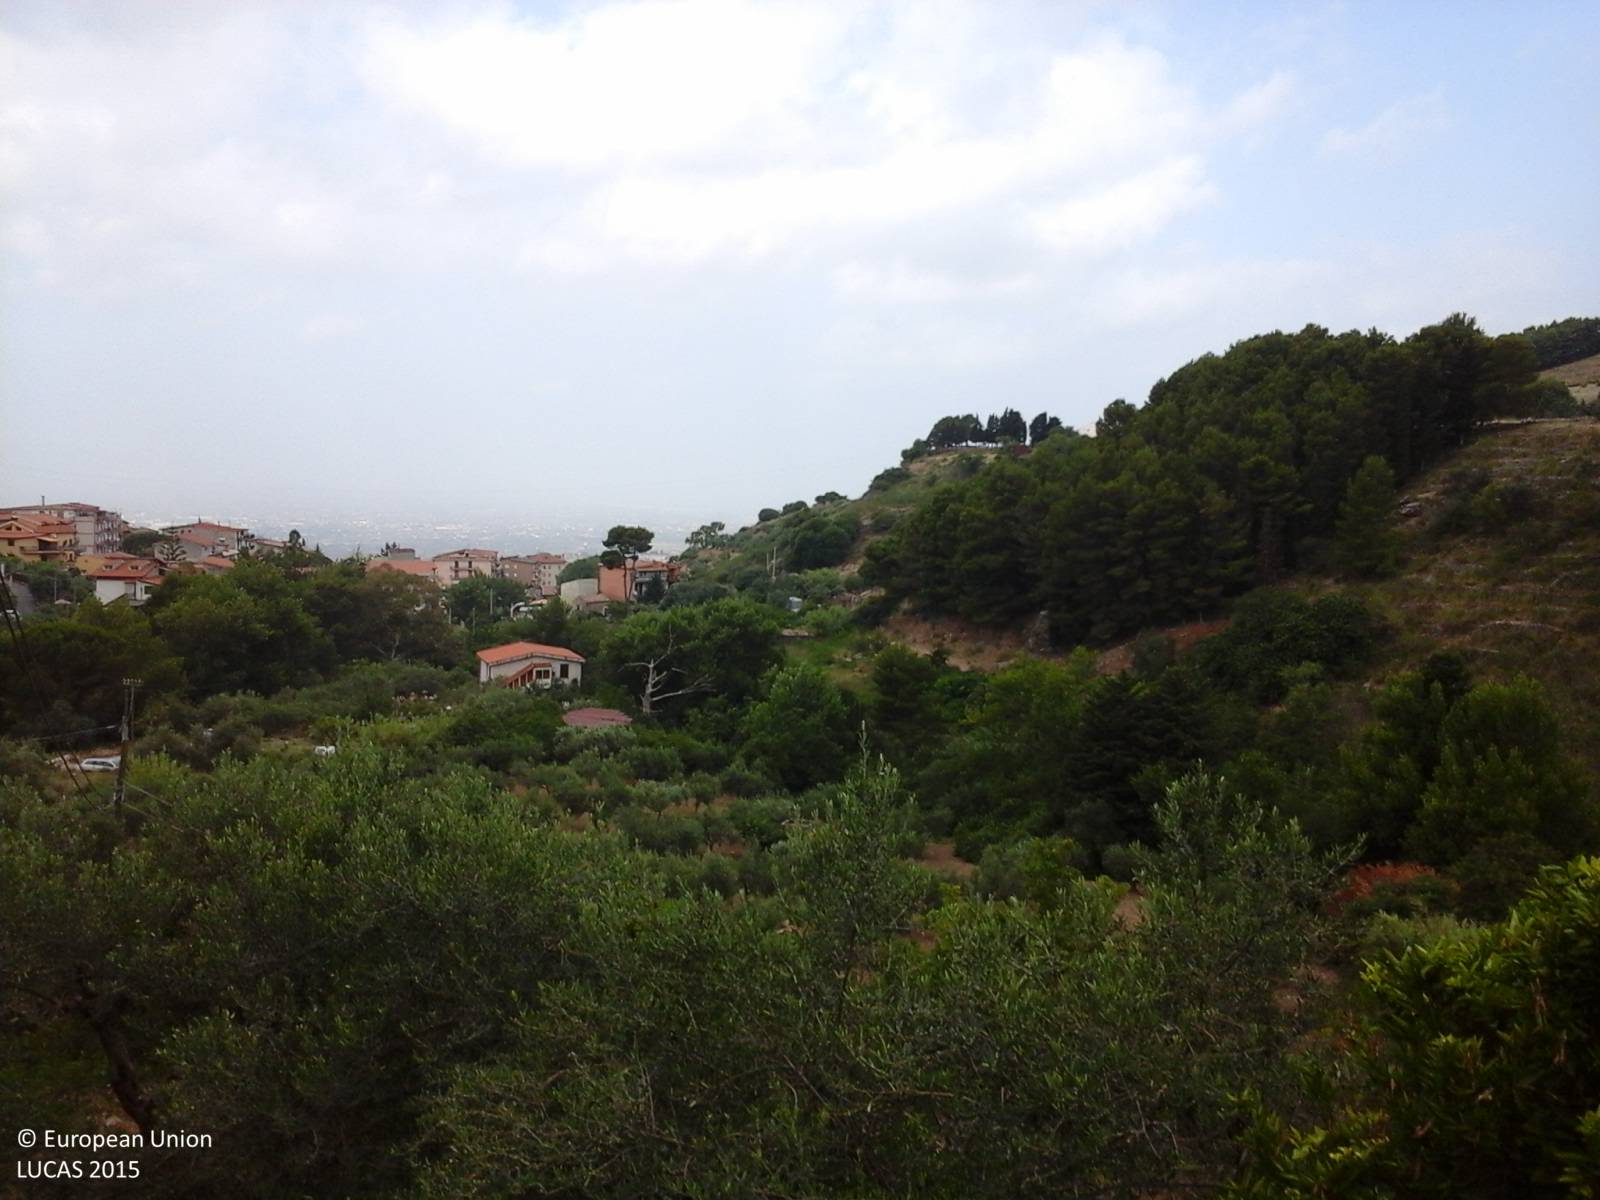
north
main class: Grassland
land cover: Grassland with sparse tree/shrub cover
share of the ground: > 75 %
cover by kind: herbaceous plants 85 %, shrubs 10 %, coniferous forest trees 5 %
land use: Semi-natural and natural areas not in use
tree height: < 5 m
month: July
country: IT
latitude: 38.0939
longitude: 13.1817
